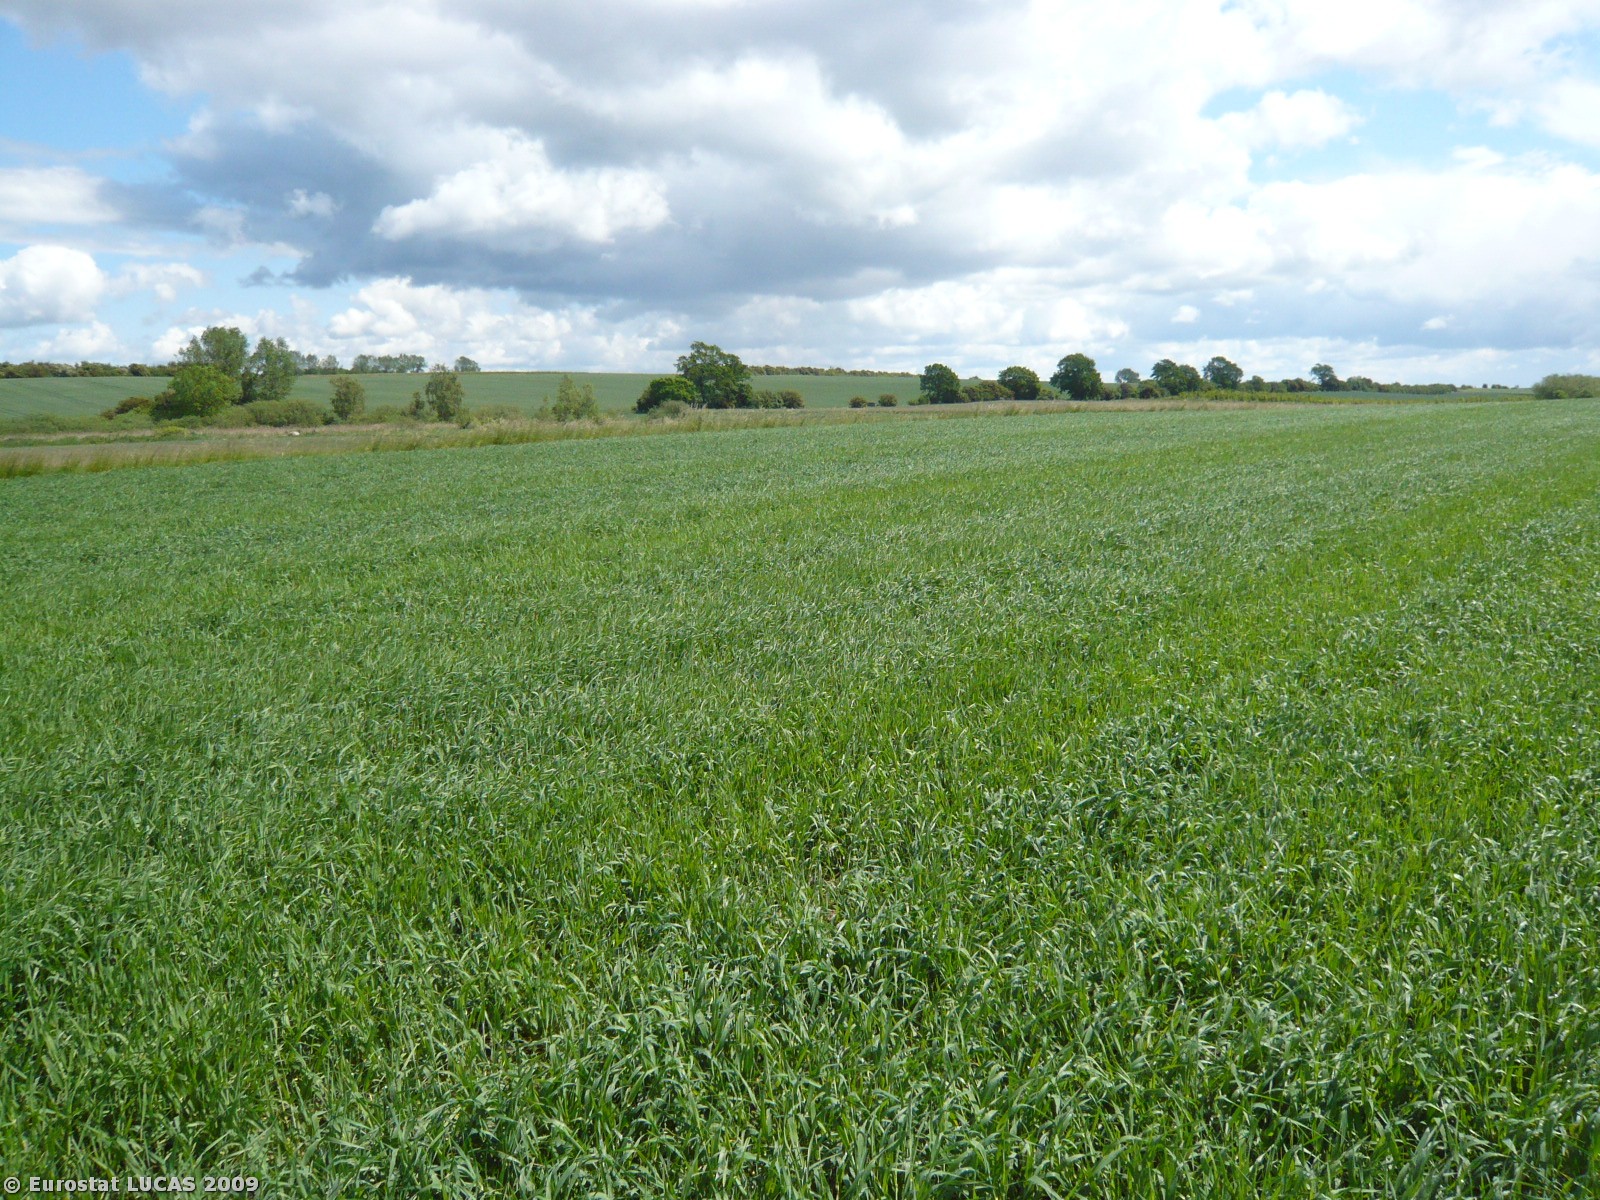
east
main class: Cropland
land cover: Barley
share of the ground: > 75 %
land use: Agriculture (excluding fallow land and kitchen gardens)
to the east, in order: Barley; Grass margins; Paved roads, cycling and walking lanes; Grass margins; Barley
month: June
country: DK
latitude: 55.2071
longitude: 11.5859
